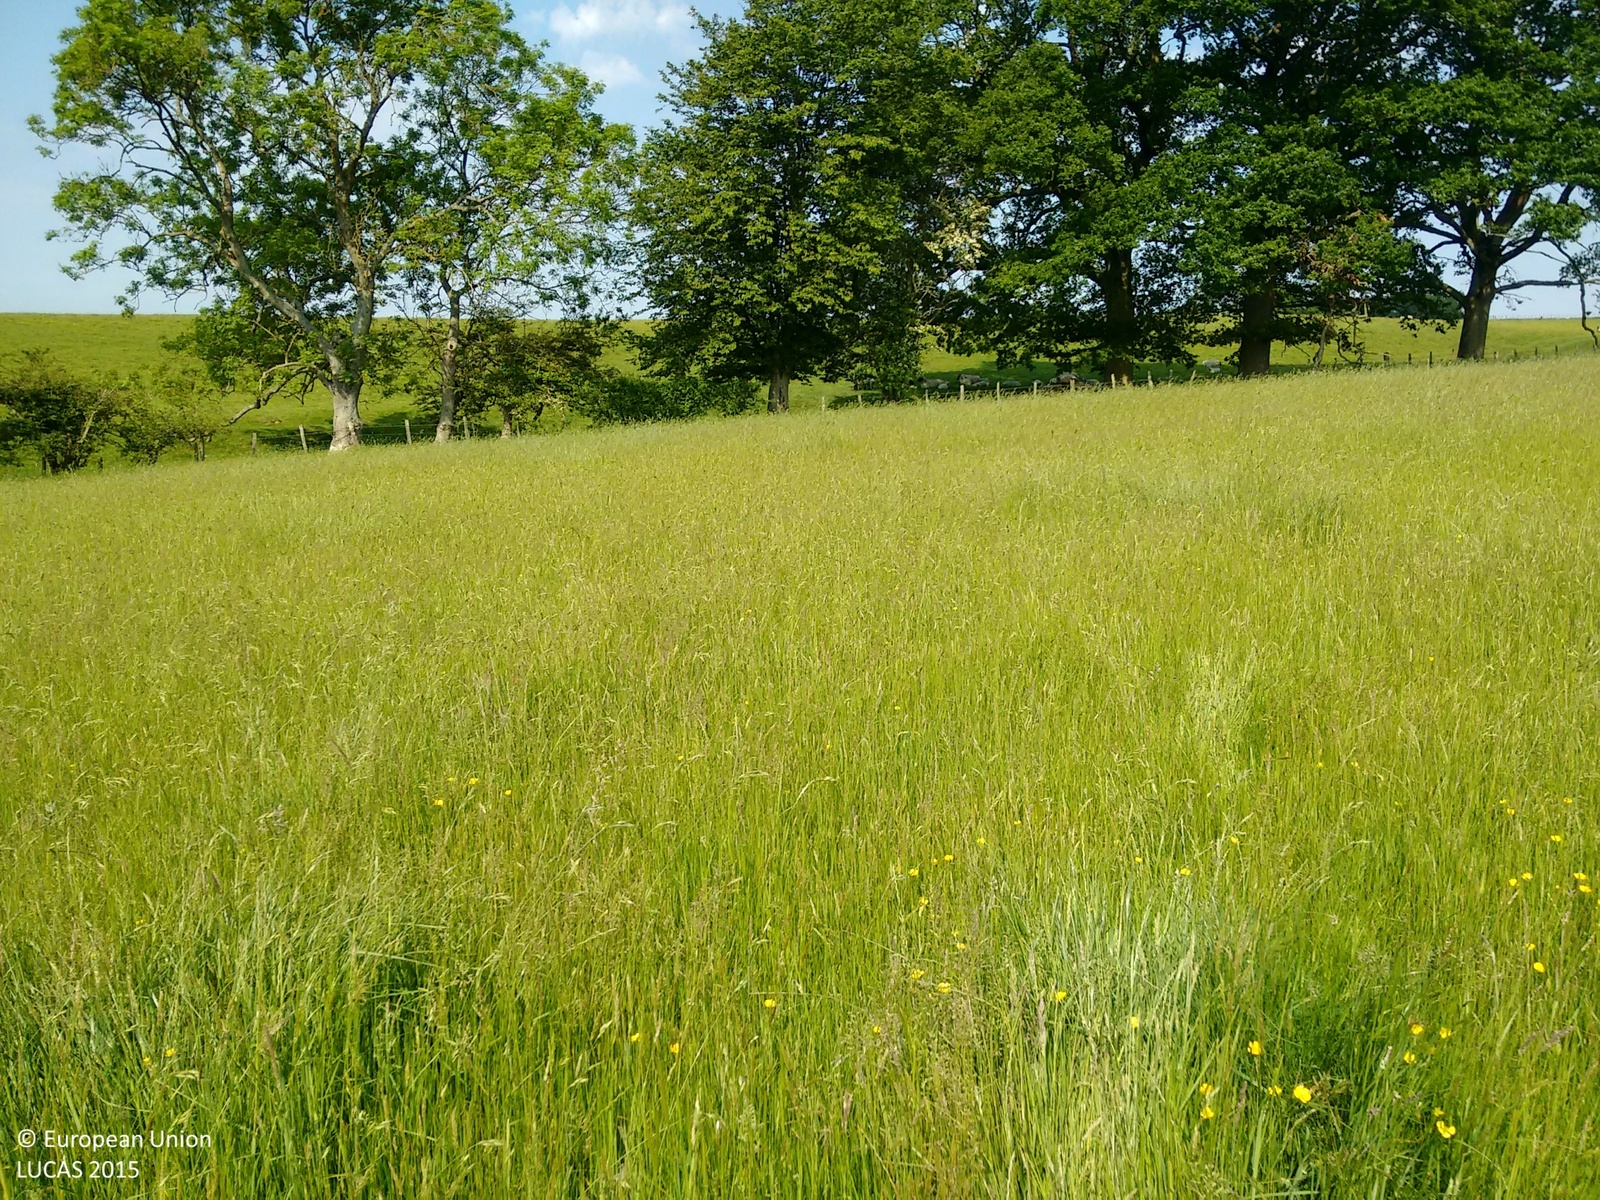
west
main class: Grassland
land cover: Grassland without tree/shrub cover
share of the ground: > 75 %
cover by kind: herbaceous plants 100 %
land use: Agriculture (excluding fallow land and kitchen gardens)
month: June
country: GB
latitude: 51.0669
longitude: 0.6551
